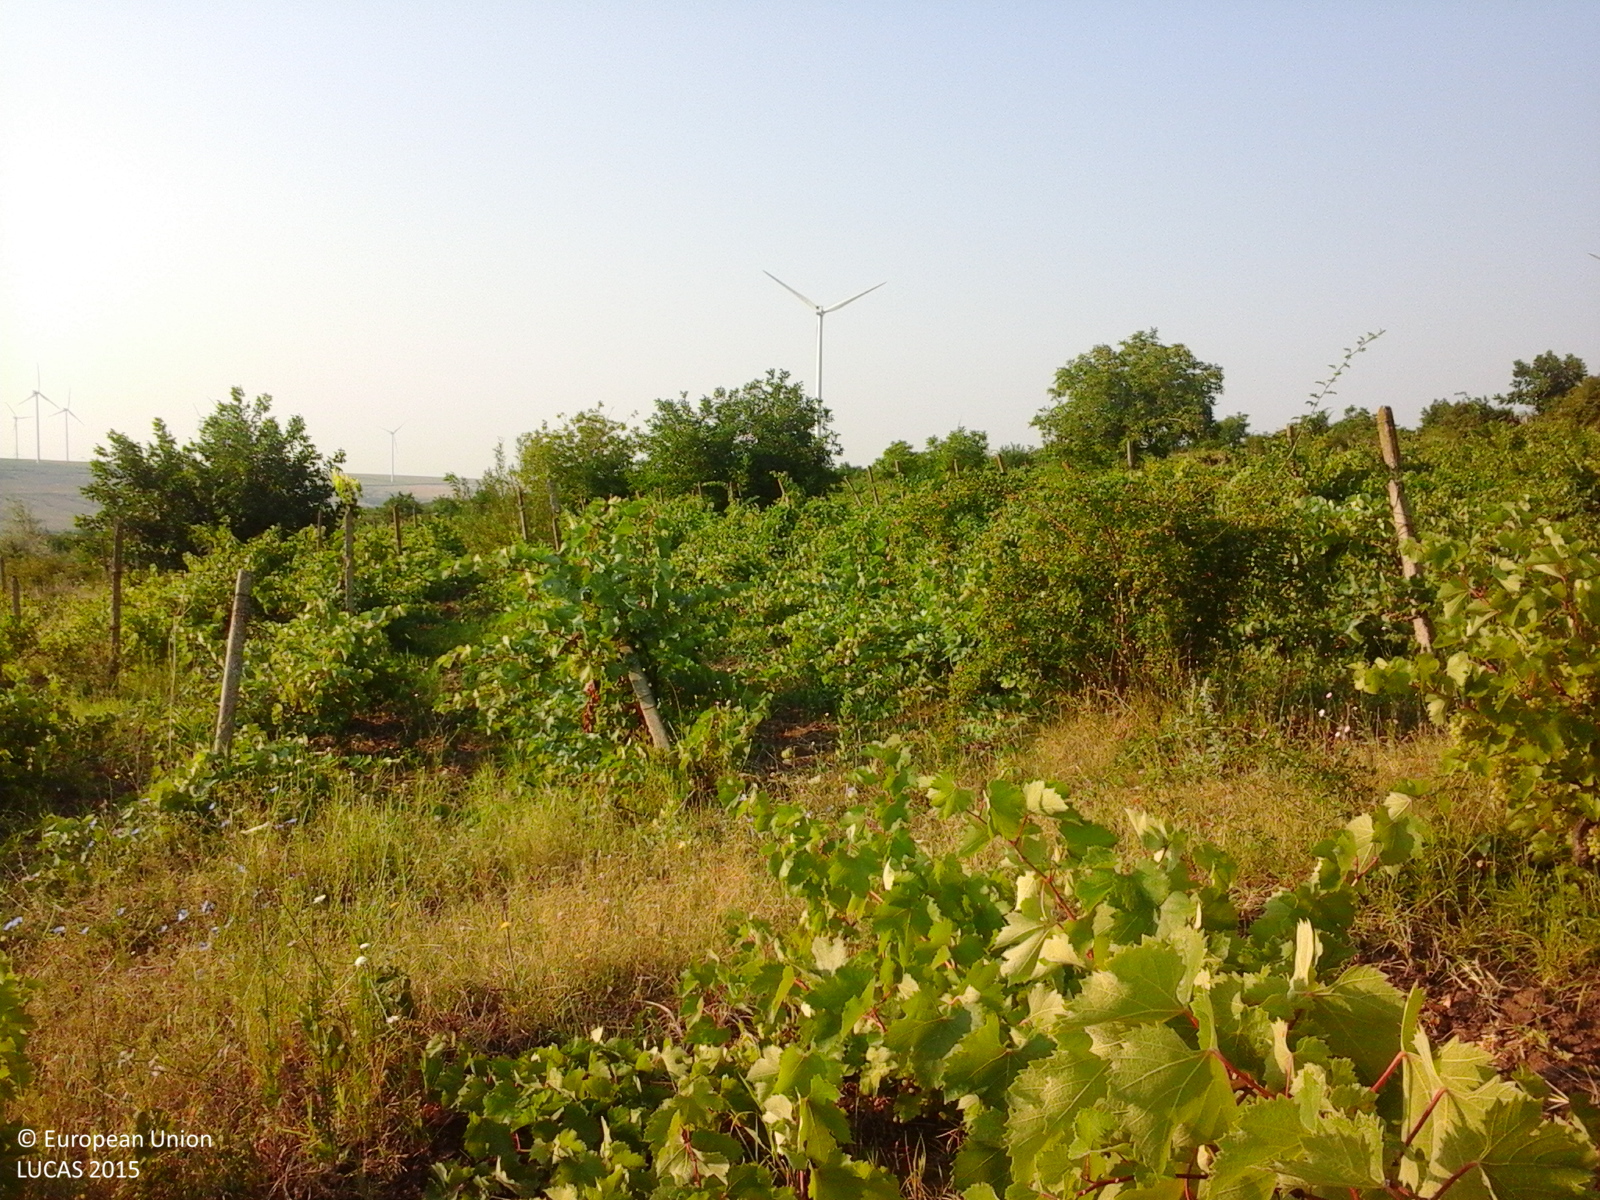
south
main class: Cropland
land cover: Vineyards
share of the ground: > 75 %
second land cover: Grassland without tree/shrub cover
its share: > 75 %
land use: Agriculture (excluding fallow land and kitchen gardens)
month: July
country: RO
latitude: 45.8476
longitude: 27.7415
